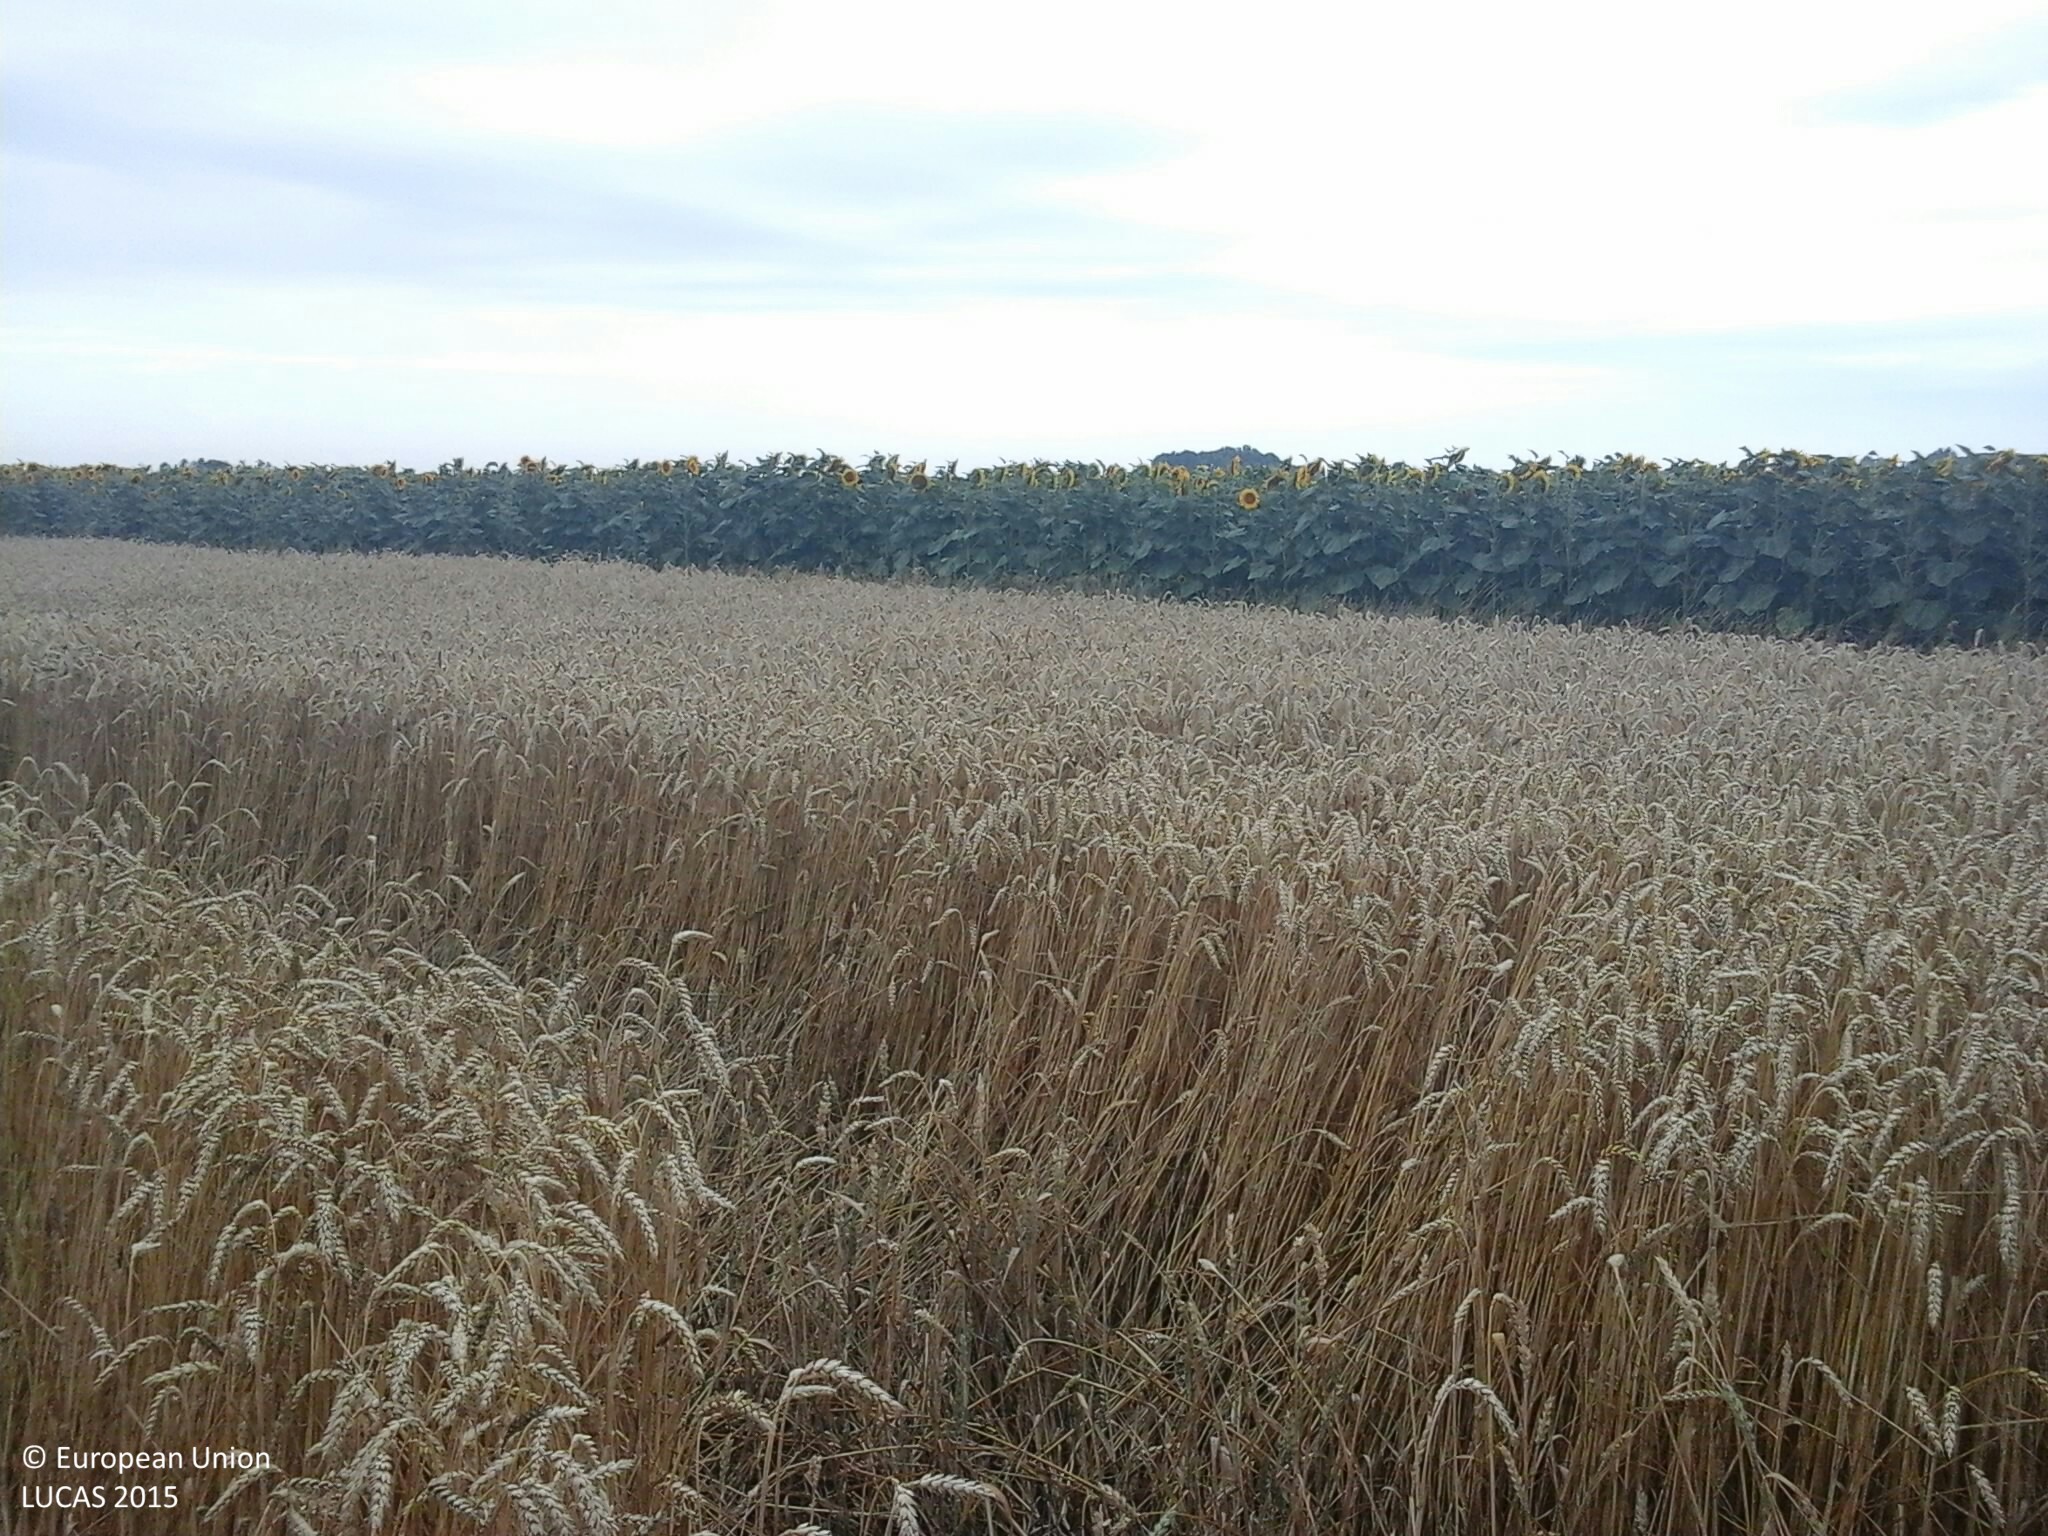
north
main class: Cropland
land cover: Common wheat
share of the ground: > 75 %
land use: Agriculture (excluding fallow land and kitchen gardens)
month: July
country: HU
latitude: 46.6450
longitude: 20.1755
